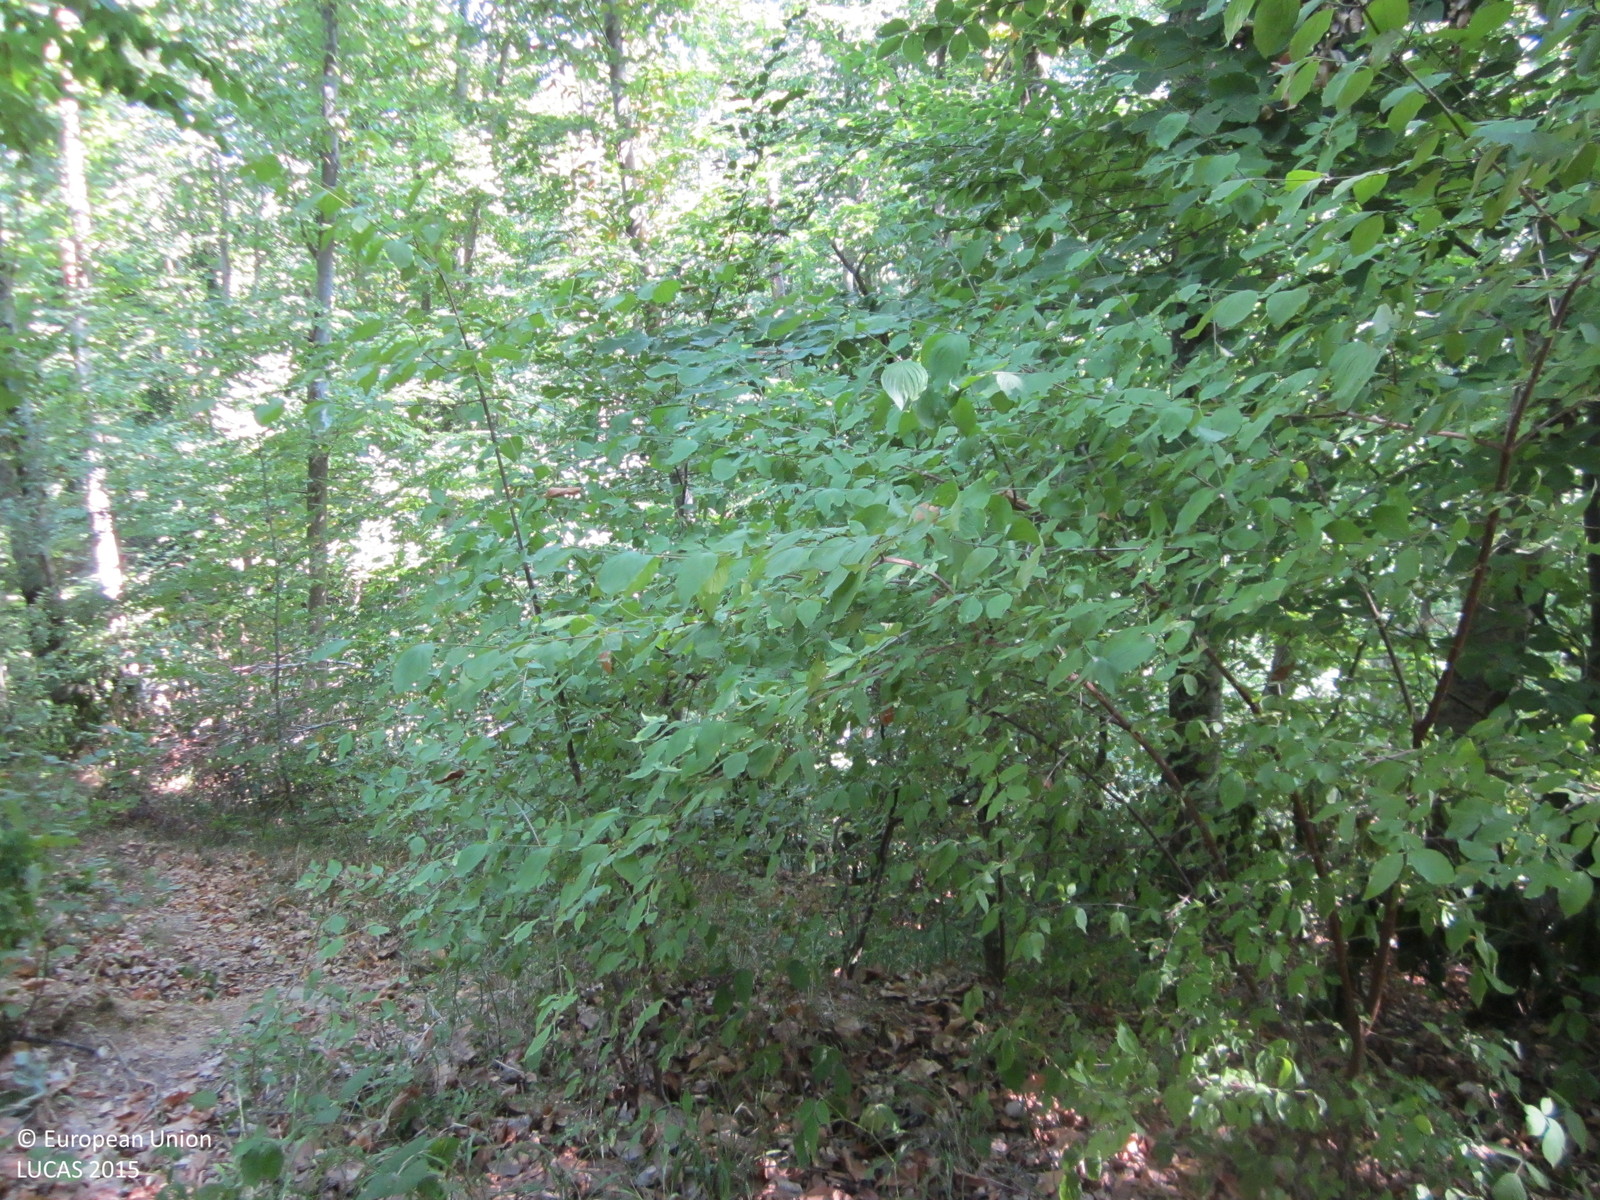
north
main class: Woodland
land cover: Broadleaved woodland
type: thermophilous deciduous forest
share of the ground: > 75 %
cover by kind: broadleaved forest trees 90 %, lichens and mosses 5 %, unconsolidated bare surface 5 %
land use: Forestry
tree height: > 5 m
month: August
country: BG
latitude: 42.0890
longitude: 27.7330
